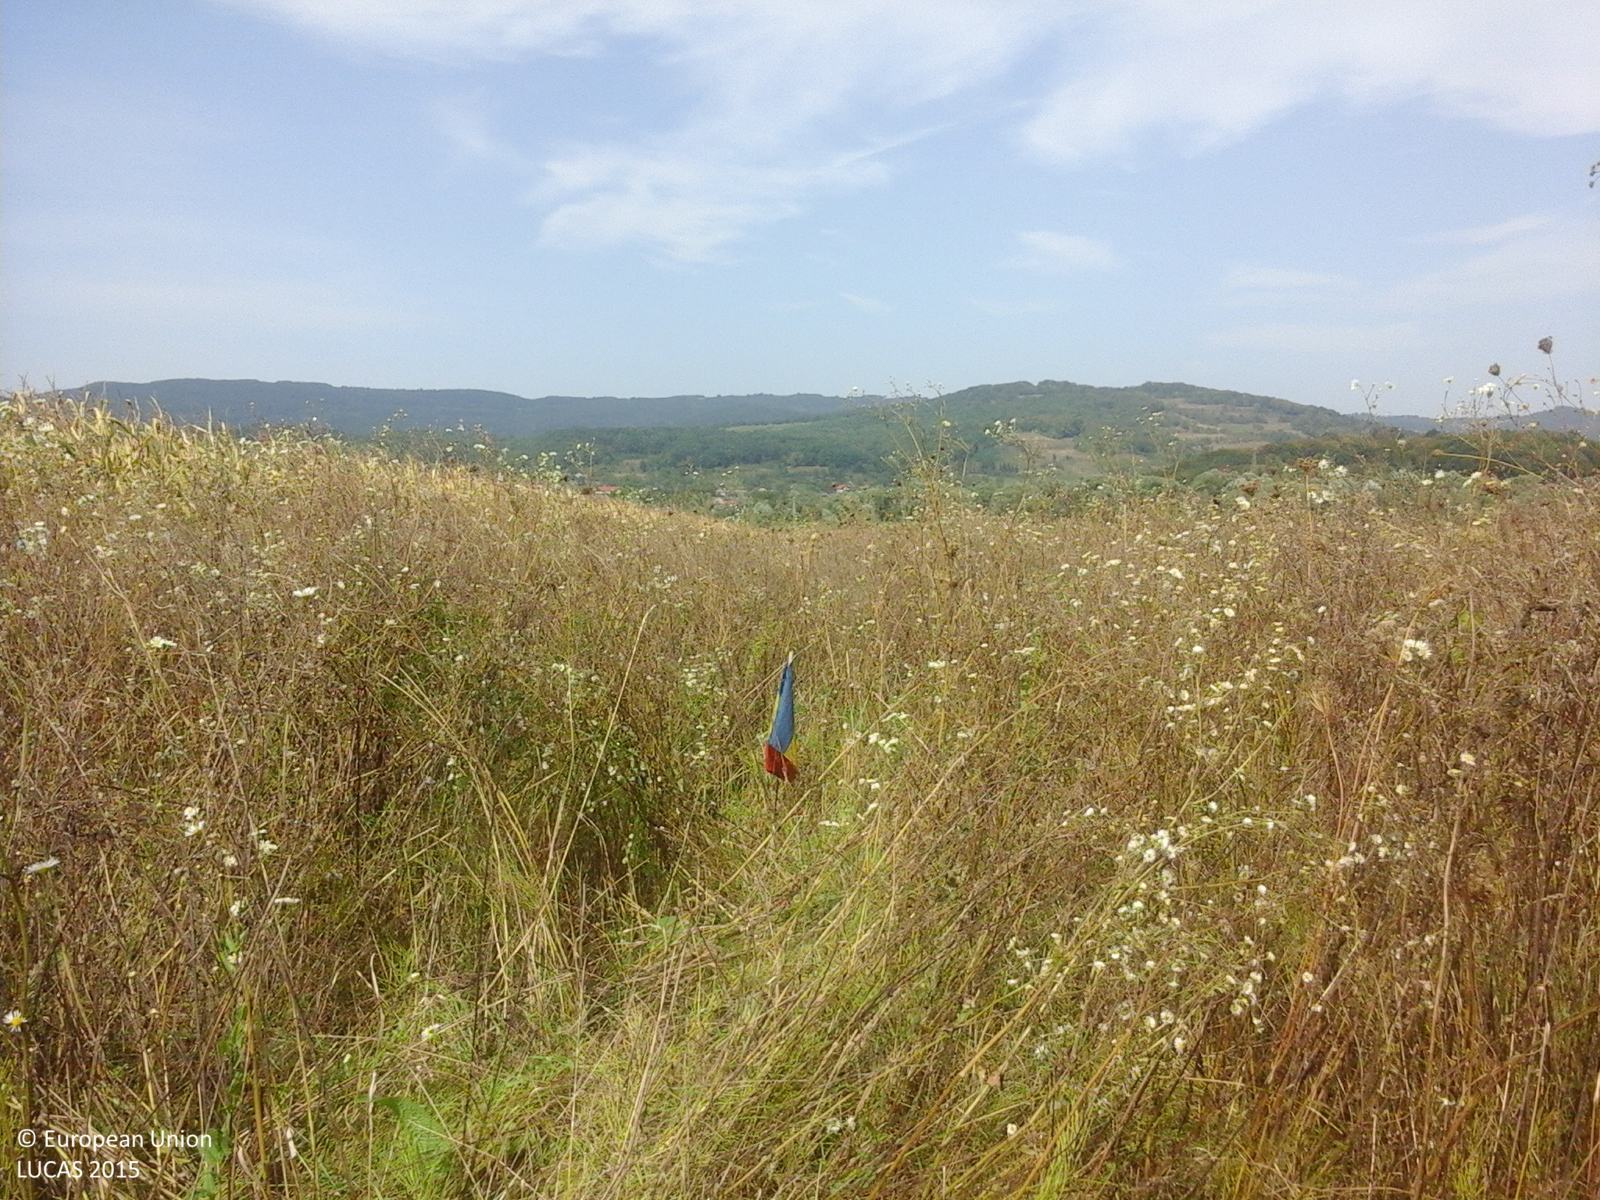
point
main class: Grassland
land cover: Spontaneously vegetated surfaces
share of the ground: > 75 %
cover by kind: herbaceous plants 100 %
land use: Fallow land
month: September
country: RO
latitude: 47.2714
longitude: 23.7040
